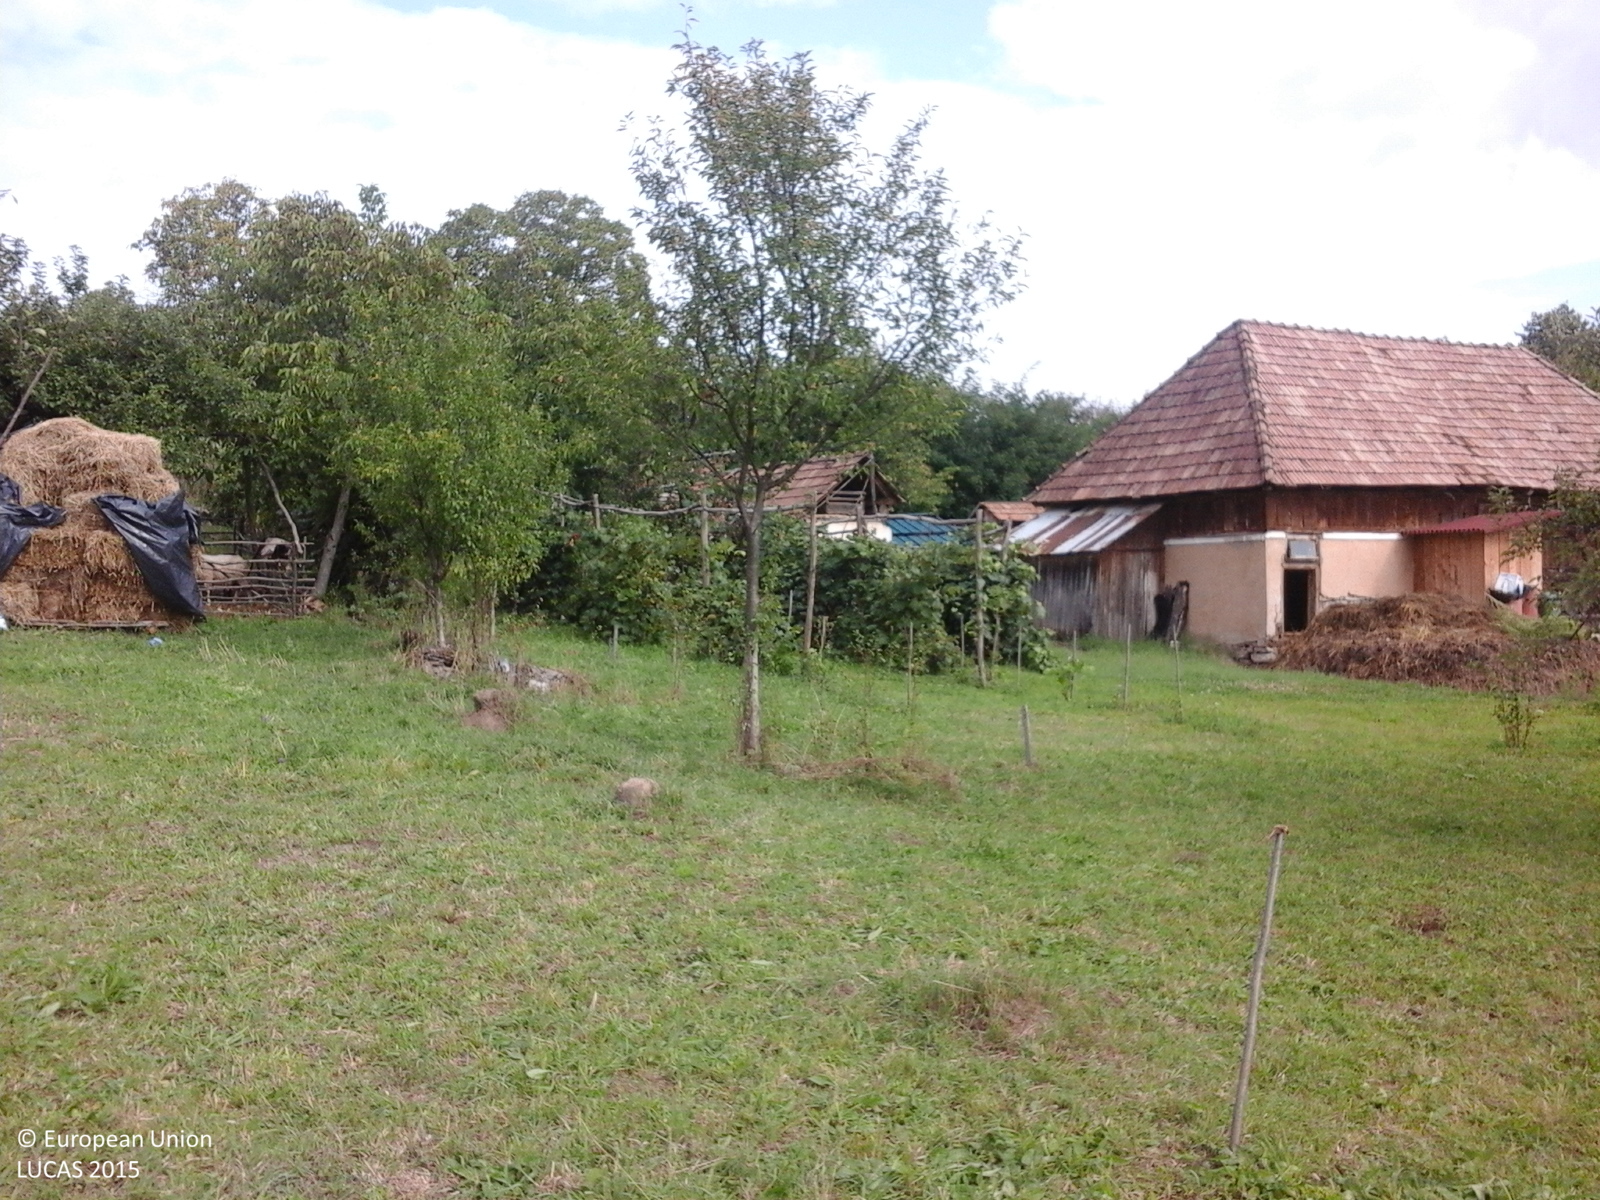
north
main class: Cropland
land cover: Apple fruit
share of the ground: 50 - 75 %
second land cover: Grassland without tree/shrub cover
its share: > 75 %
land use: Agriculture (excluding fallow land and kitchen gardens)
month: September
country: RO
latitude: 47.5306
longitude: 23.5301
